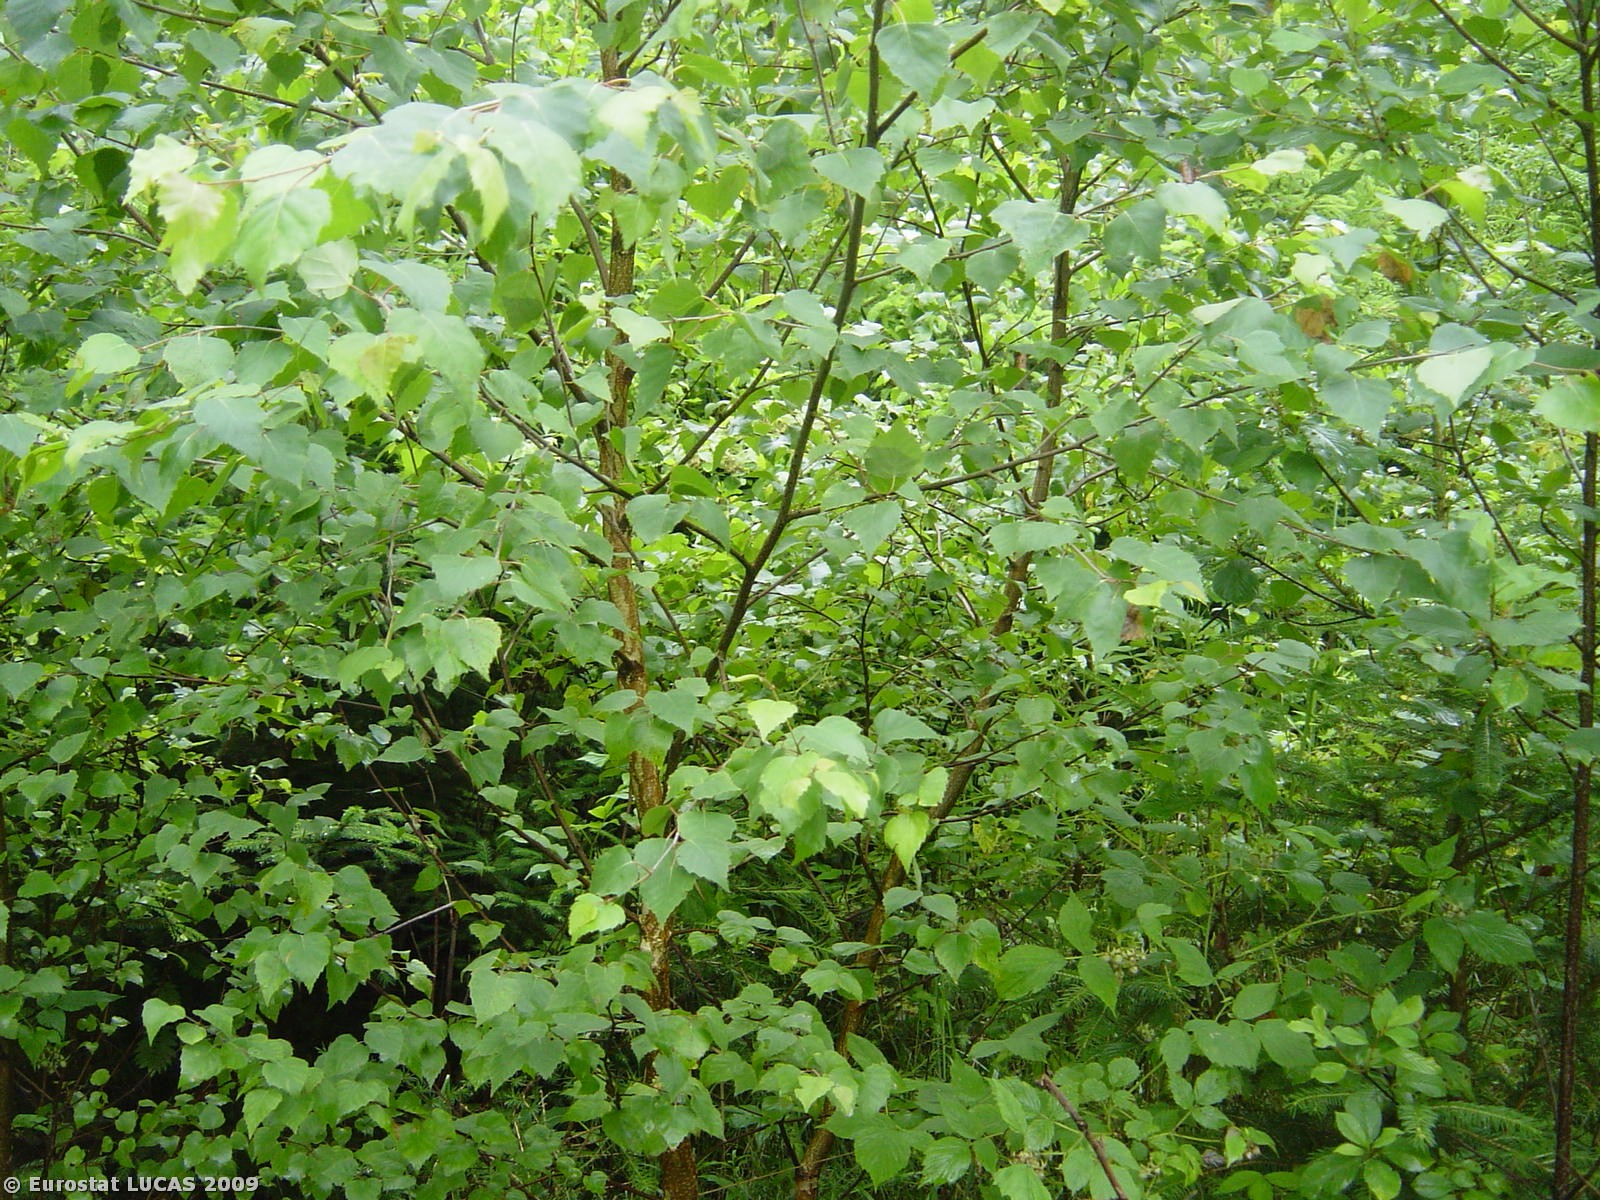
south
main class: Woodland
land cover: Mixed woodland
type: hemiboreal forest and nemoral coniferous forest and mixed broadleaved-coniferous forest
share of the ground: > 75 %
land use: Forestry
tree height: > 5 m
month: June
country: CZ
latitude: 49.6557
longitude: 16.5040
